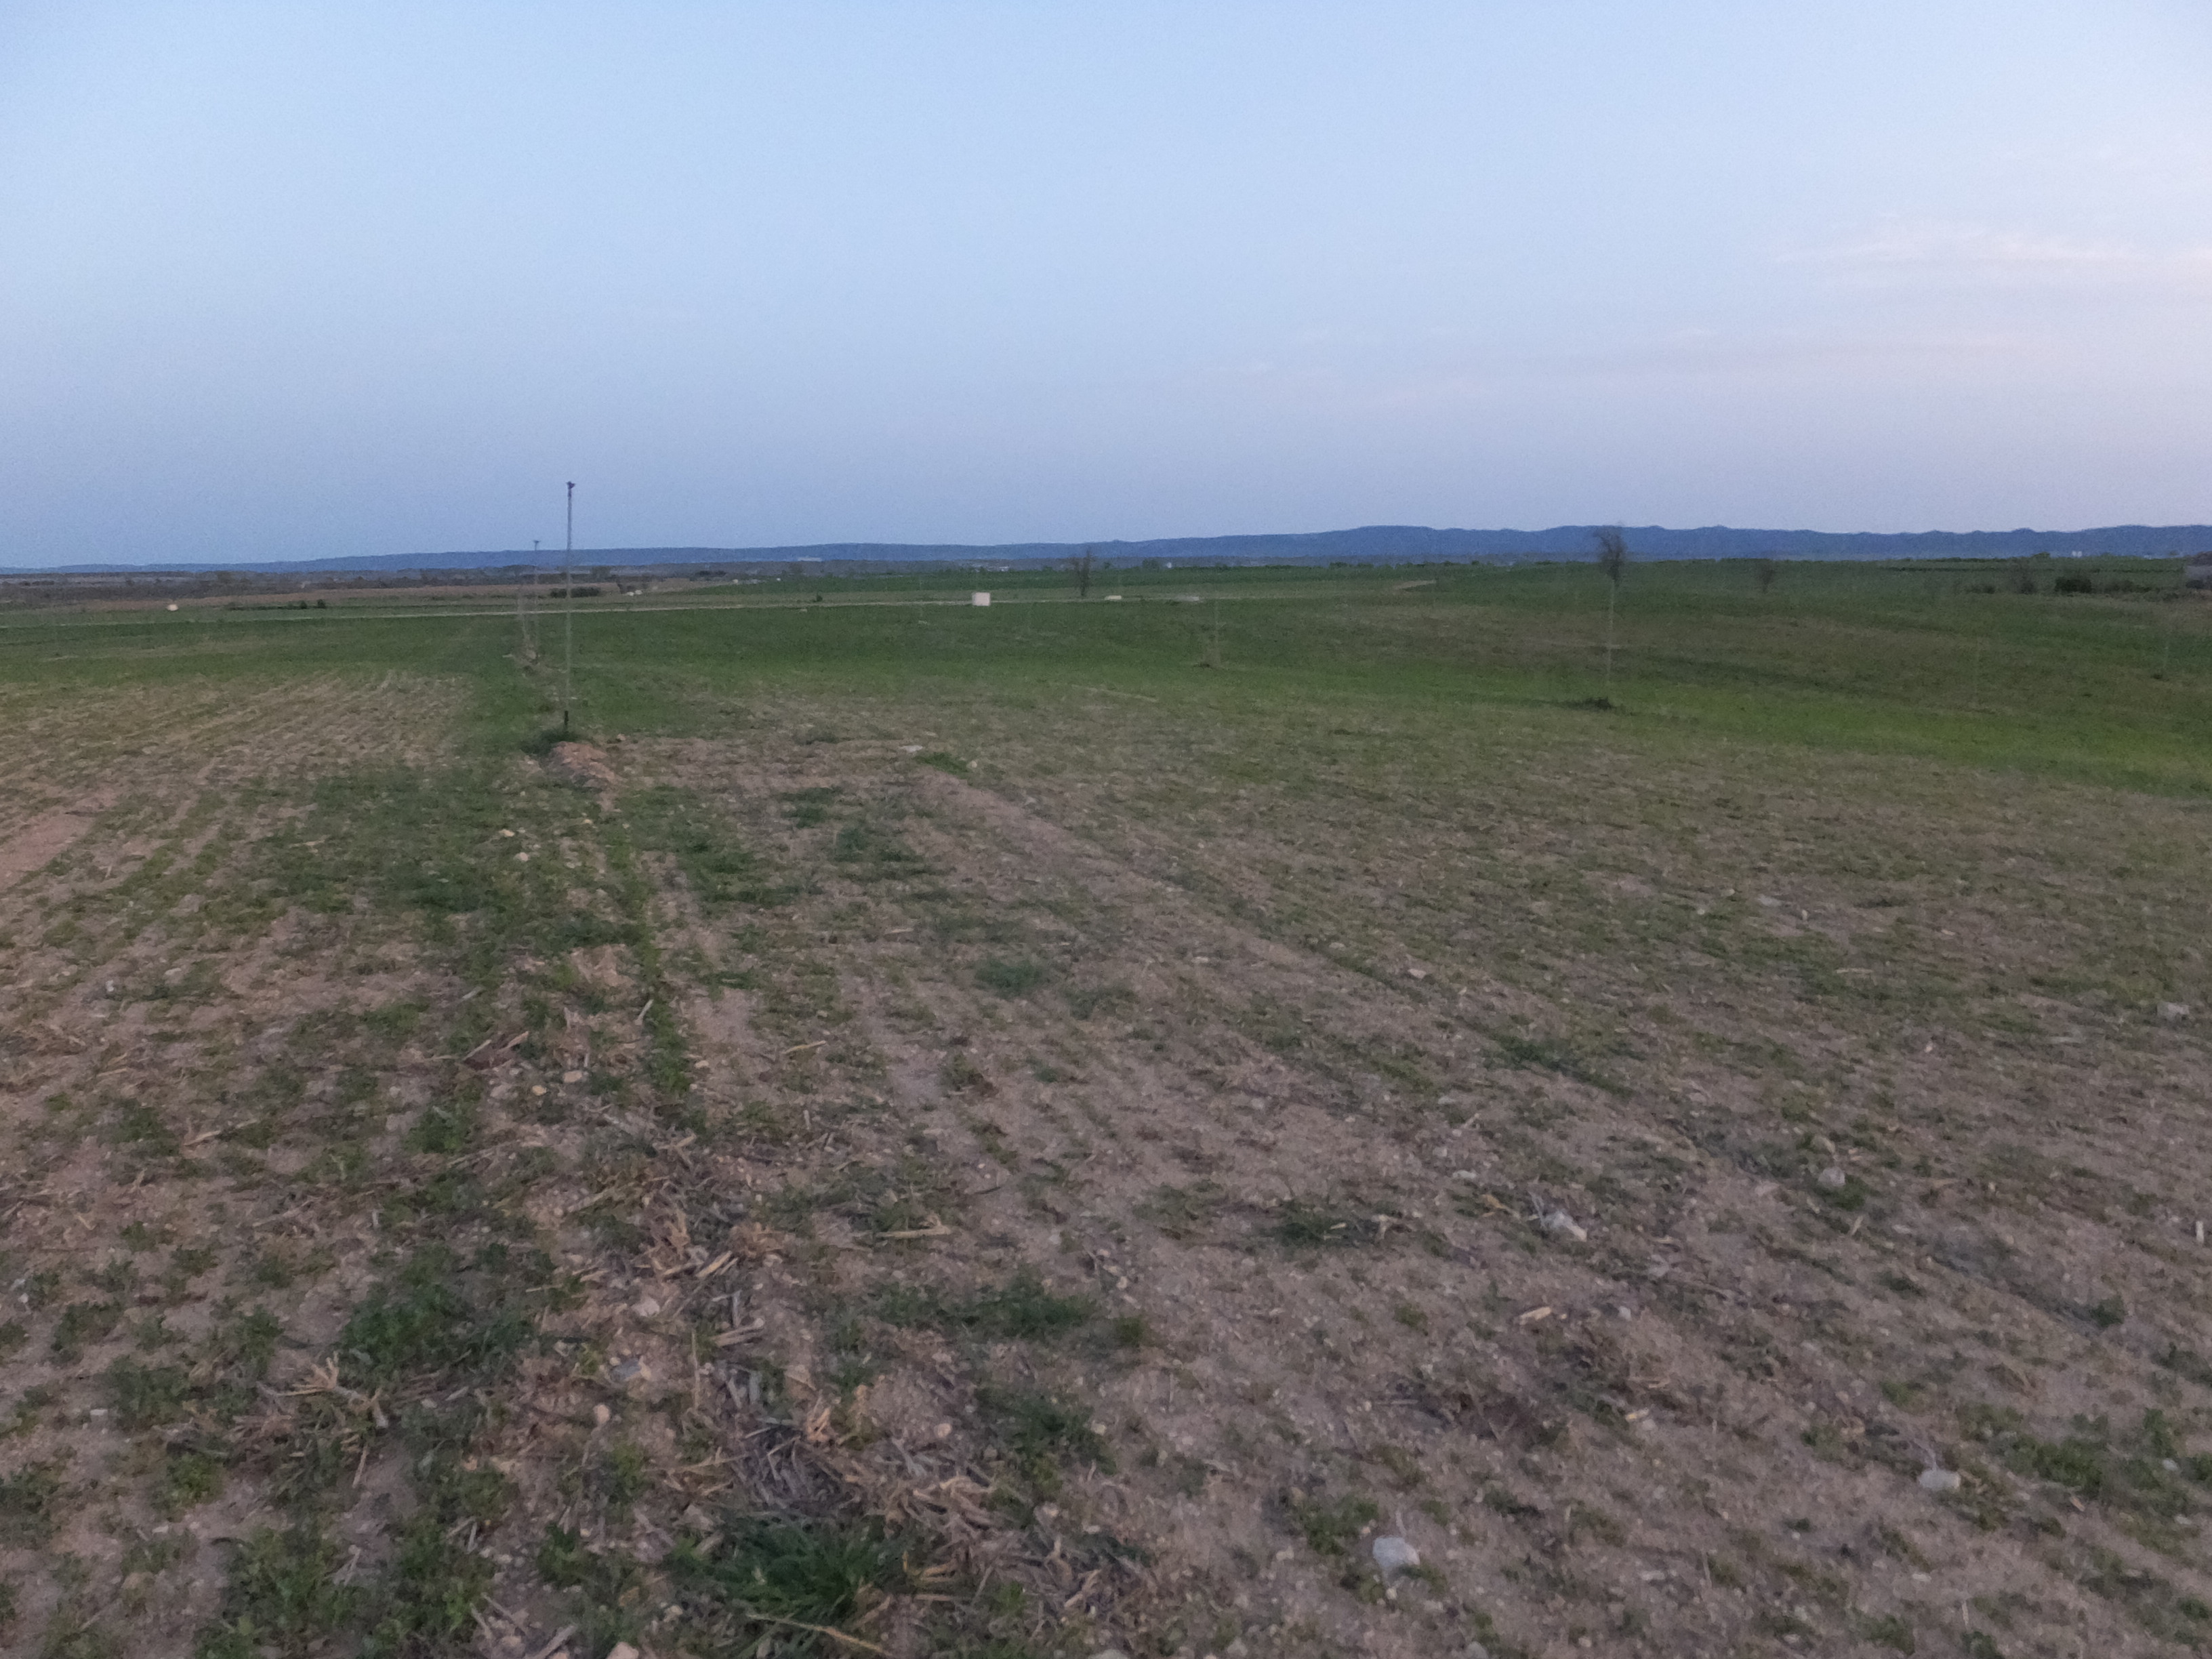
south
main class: Cropland
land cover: Lucerne
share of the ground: > 75 %
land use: Agriculture (excluding fallow land and kitchen gardens)
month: April
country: ES
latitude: 41.8324
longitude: -0.3388
